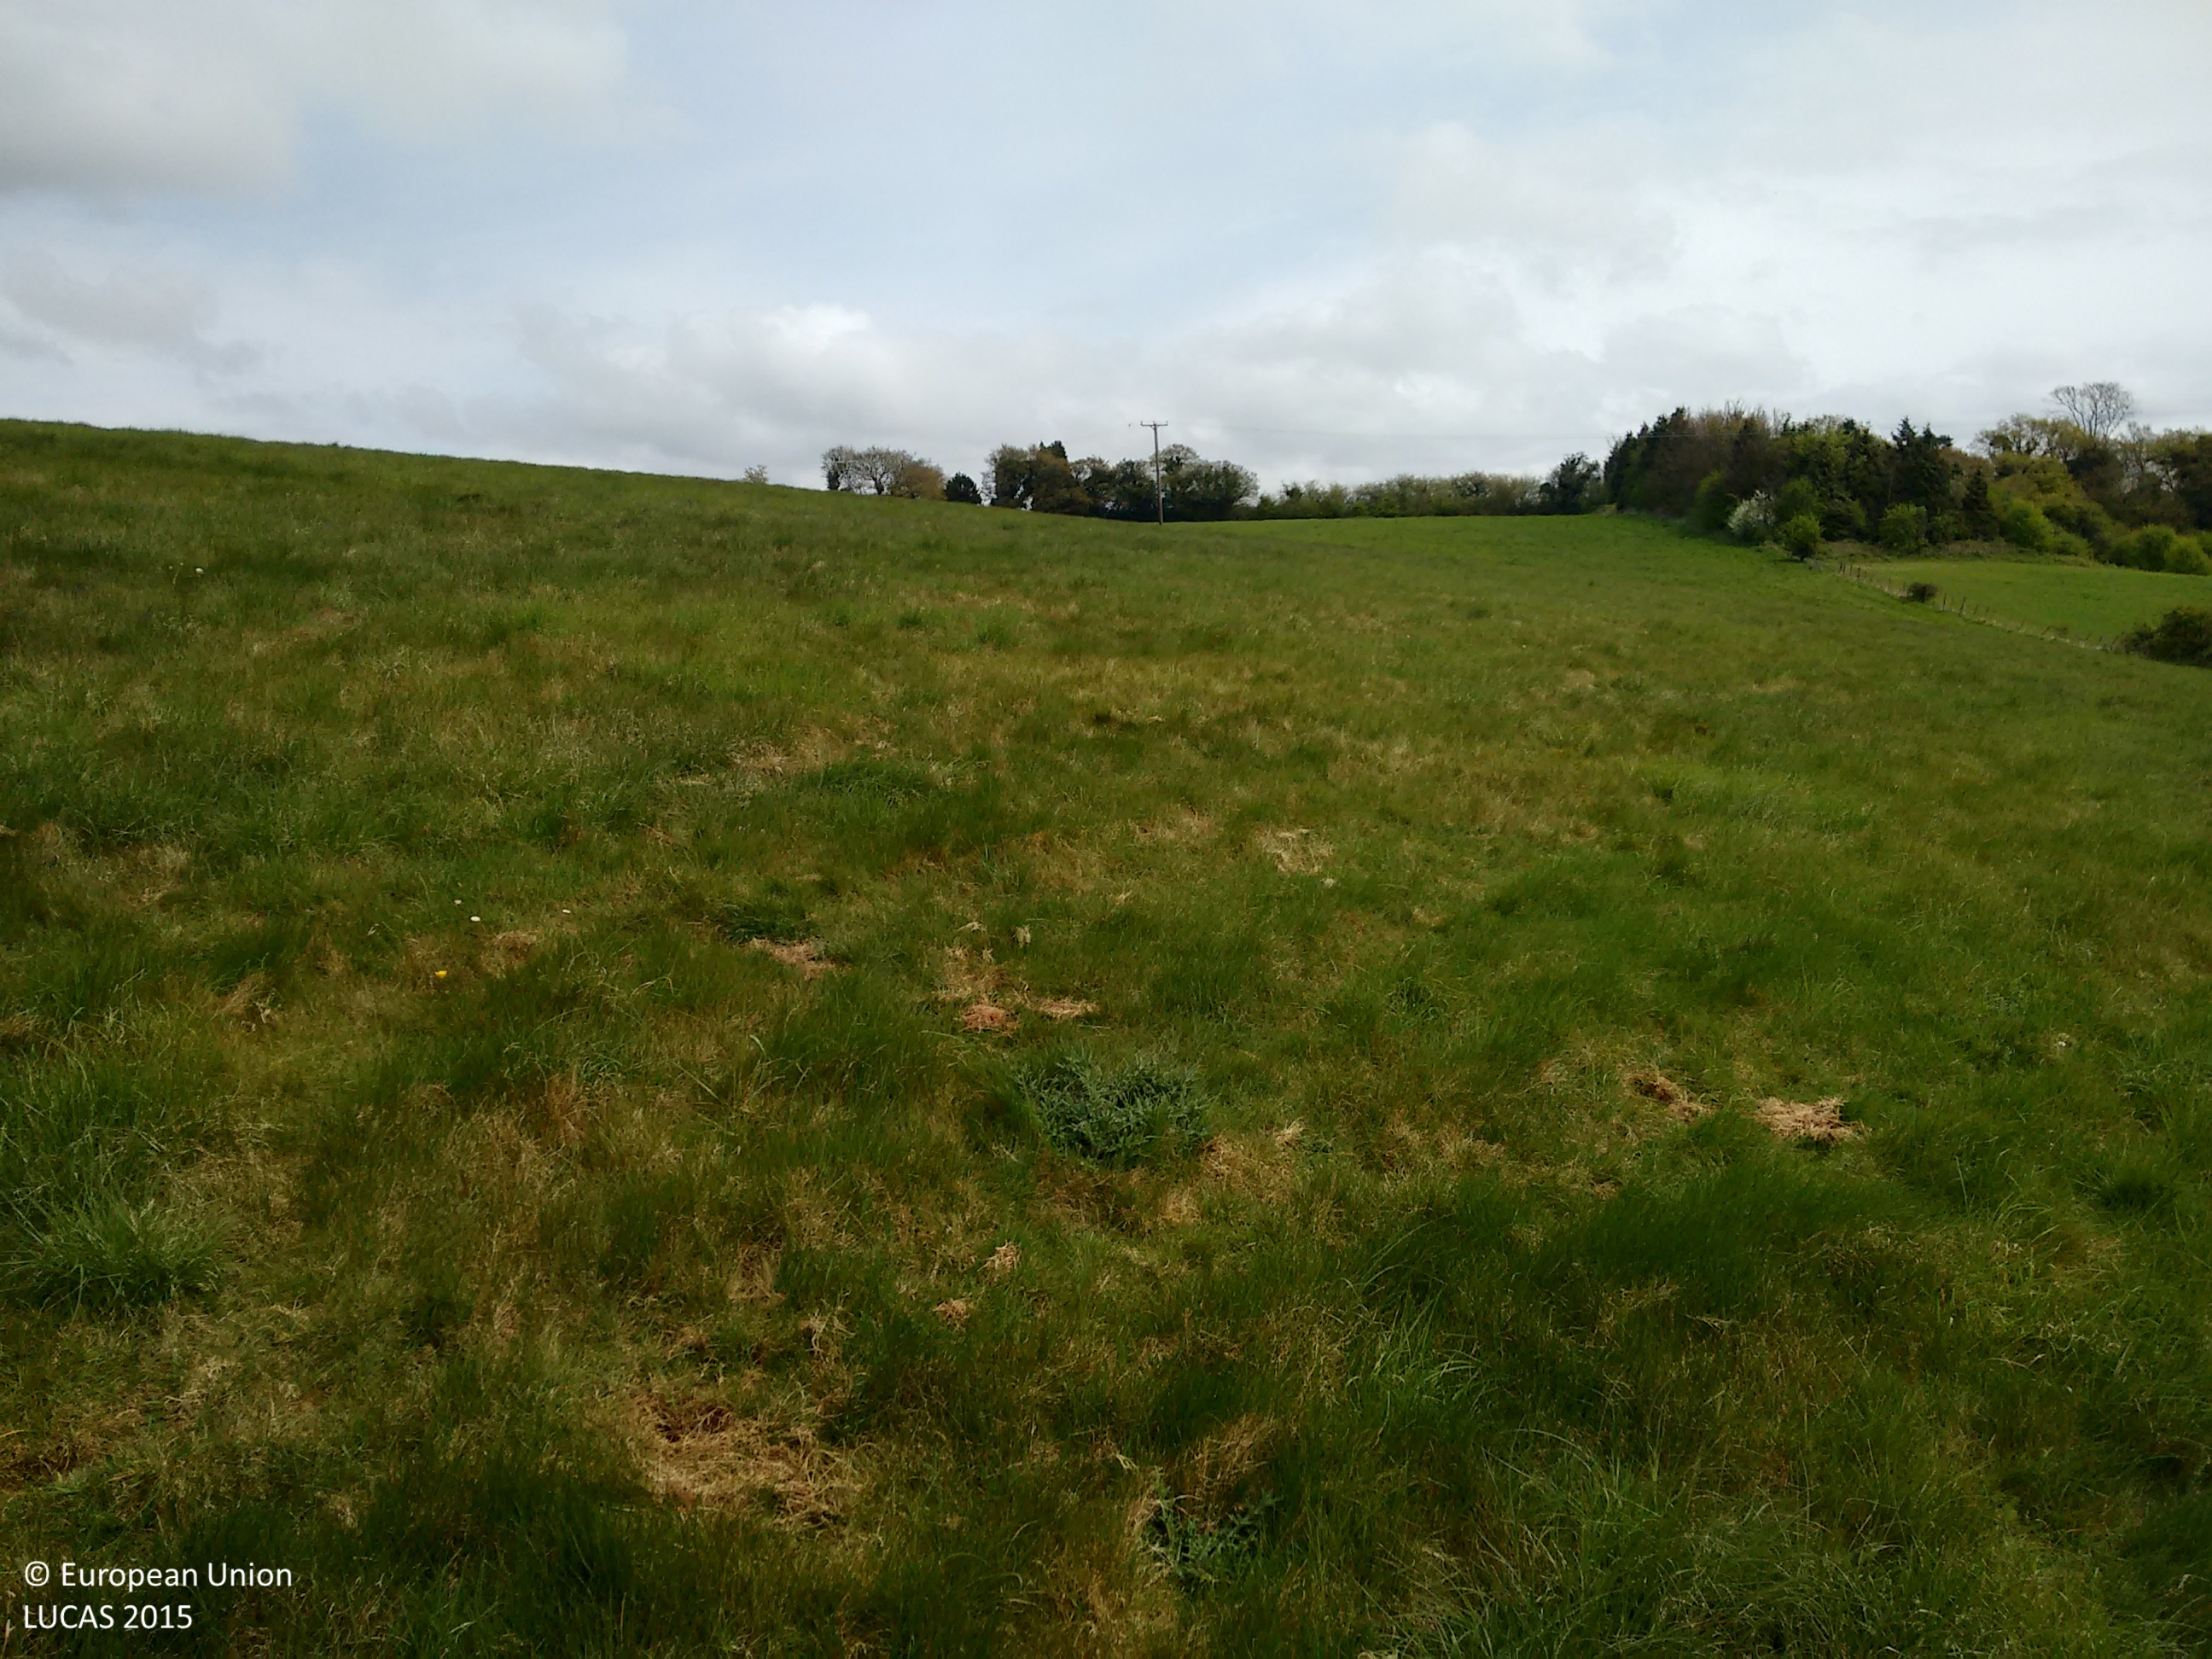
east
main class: Grassland
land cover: Grassland without tree/shrub cover
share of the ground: > 75 %
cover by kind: herbaceous plants 100 %
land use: Semi-natural and natural areas not in use
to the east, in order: Grassland without tree/shrub cover; Electric lines; Grassland without tree/shrub cover; Fences; Managed hedges; Grass margins; Paved roads, cycling and walking lanes; Grass margins; Managed hedges; Fences; Grassland without tree/shrub cover
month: May
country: GB
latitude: 51.2518
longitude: 0.7040
